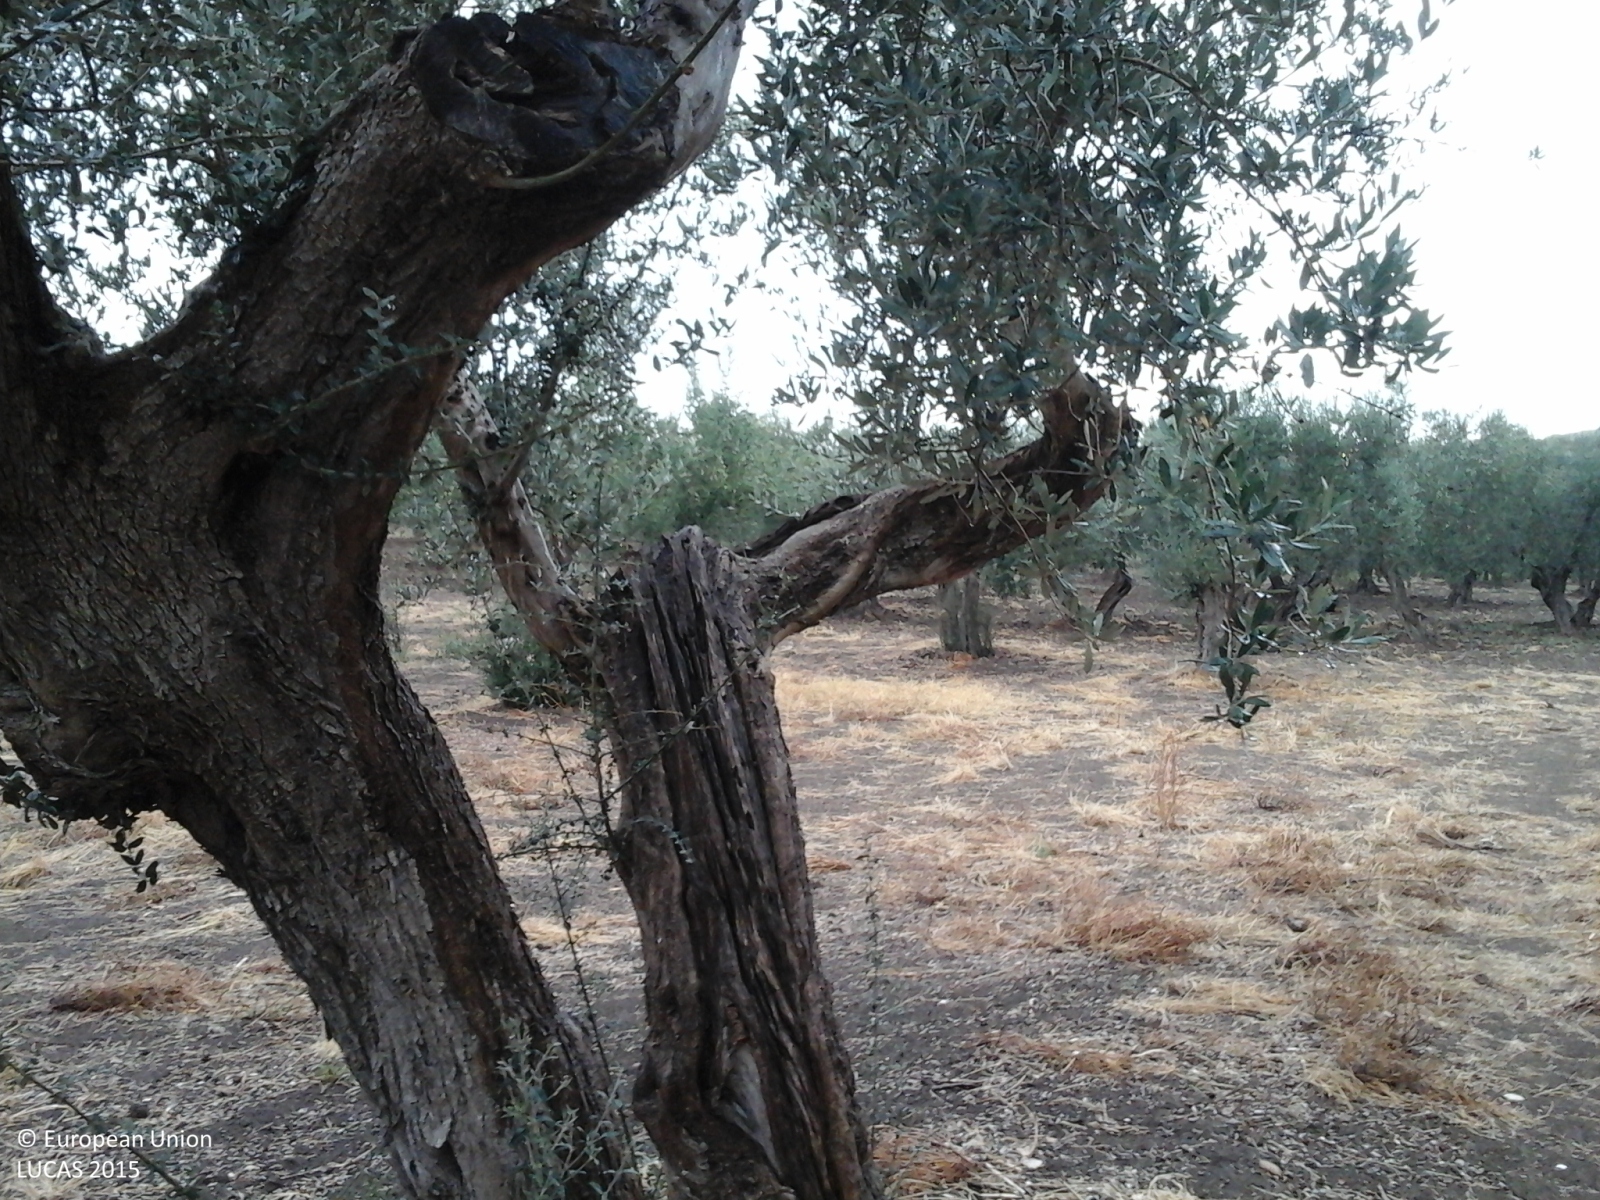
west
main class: Cropland
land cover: Olive groves
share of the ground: > 75 %
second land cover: Other bare soil
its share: > 75 %
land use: Agriculture (excluding fallow land and kitchen gardens)
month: September
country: IT
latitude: 41.7980
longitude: 15.1708
